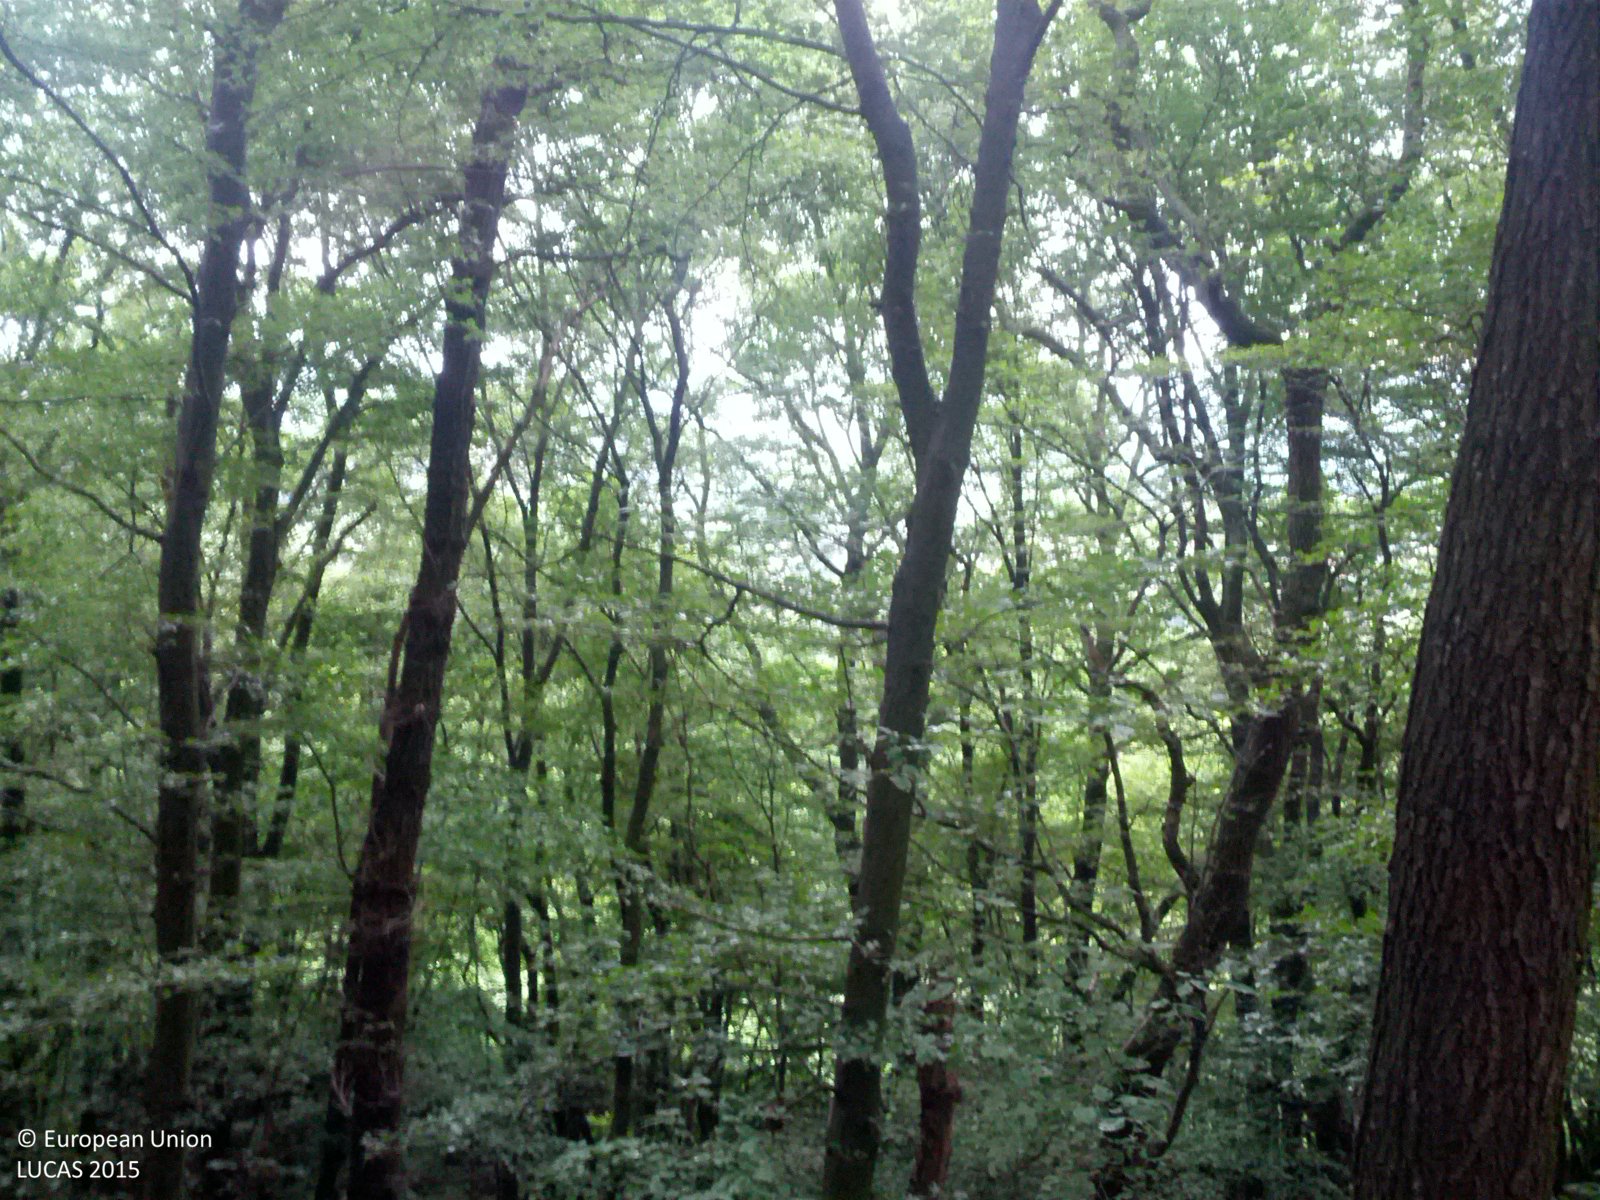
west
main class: Woodland
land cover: Broadleaved woodland
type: beech forest
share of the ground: > 75 %
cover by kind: broadleaved forest trees 90 %, herbaceous plants 10 %
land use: Forestry
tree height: > 5 m
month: May
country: AT
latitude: 48.2872
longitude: 16.1365
